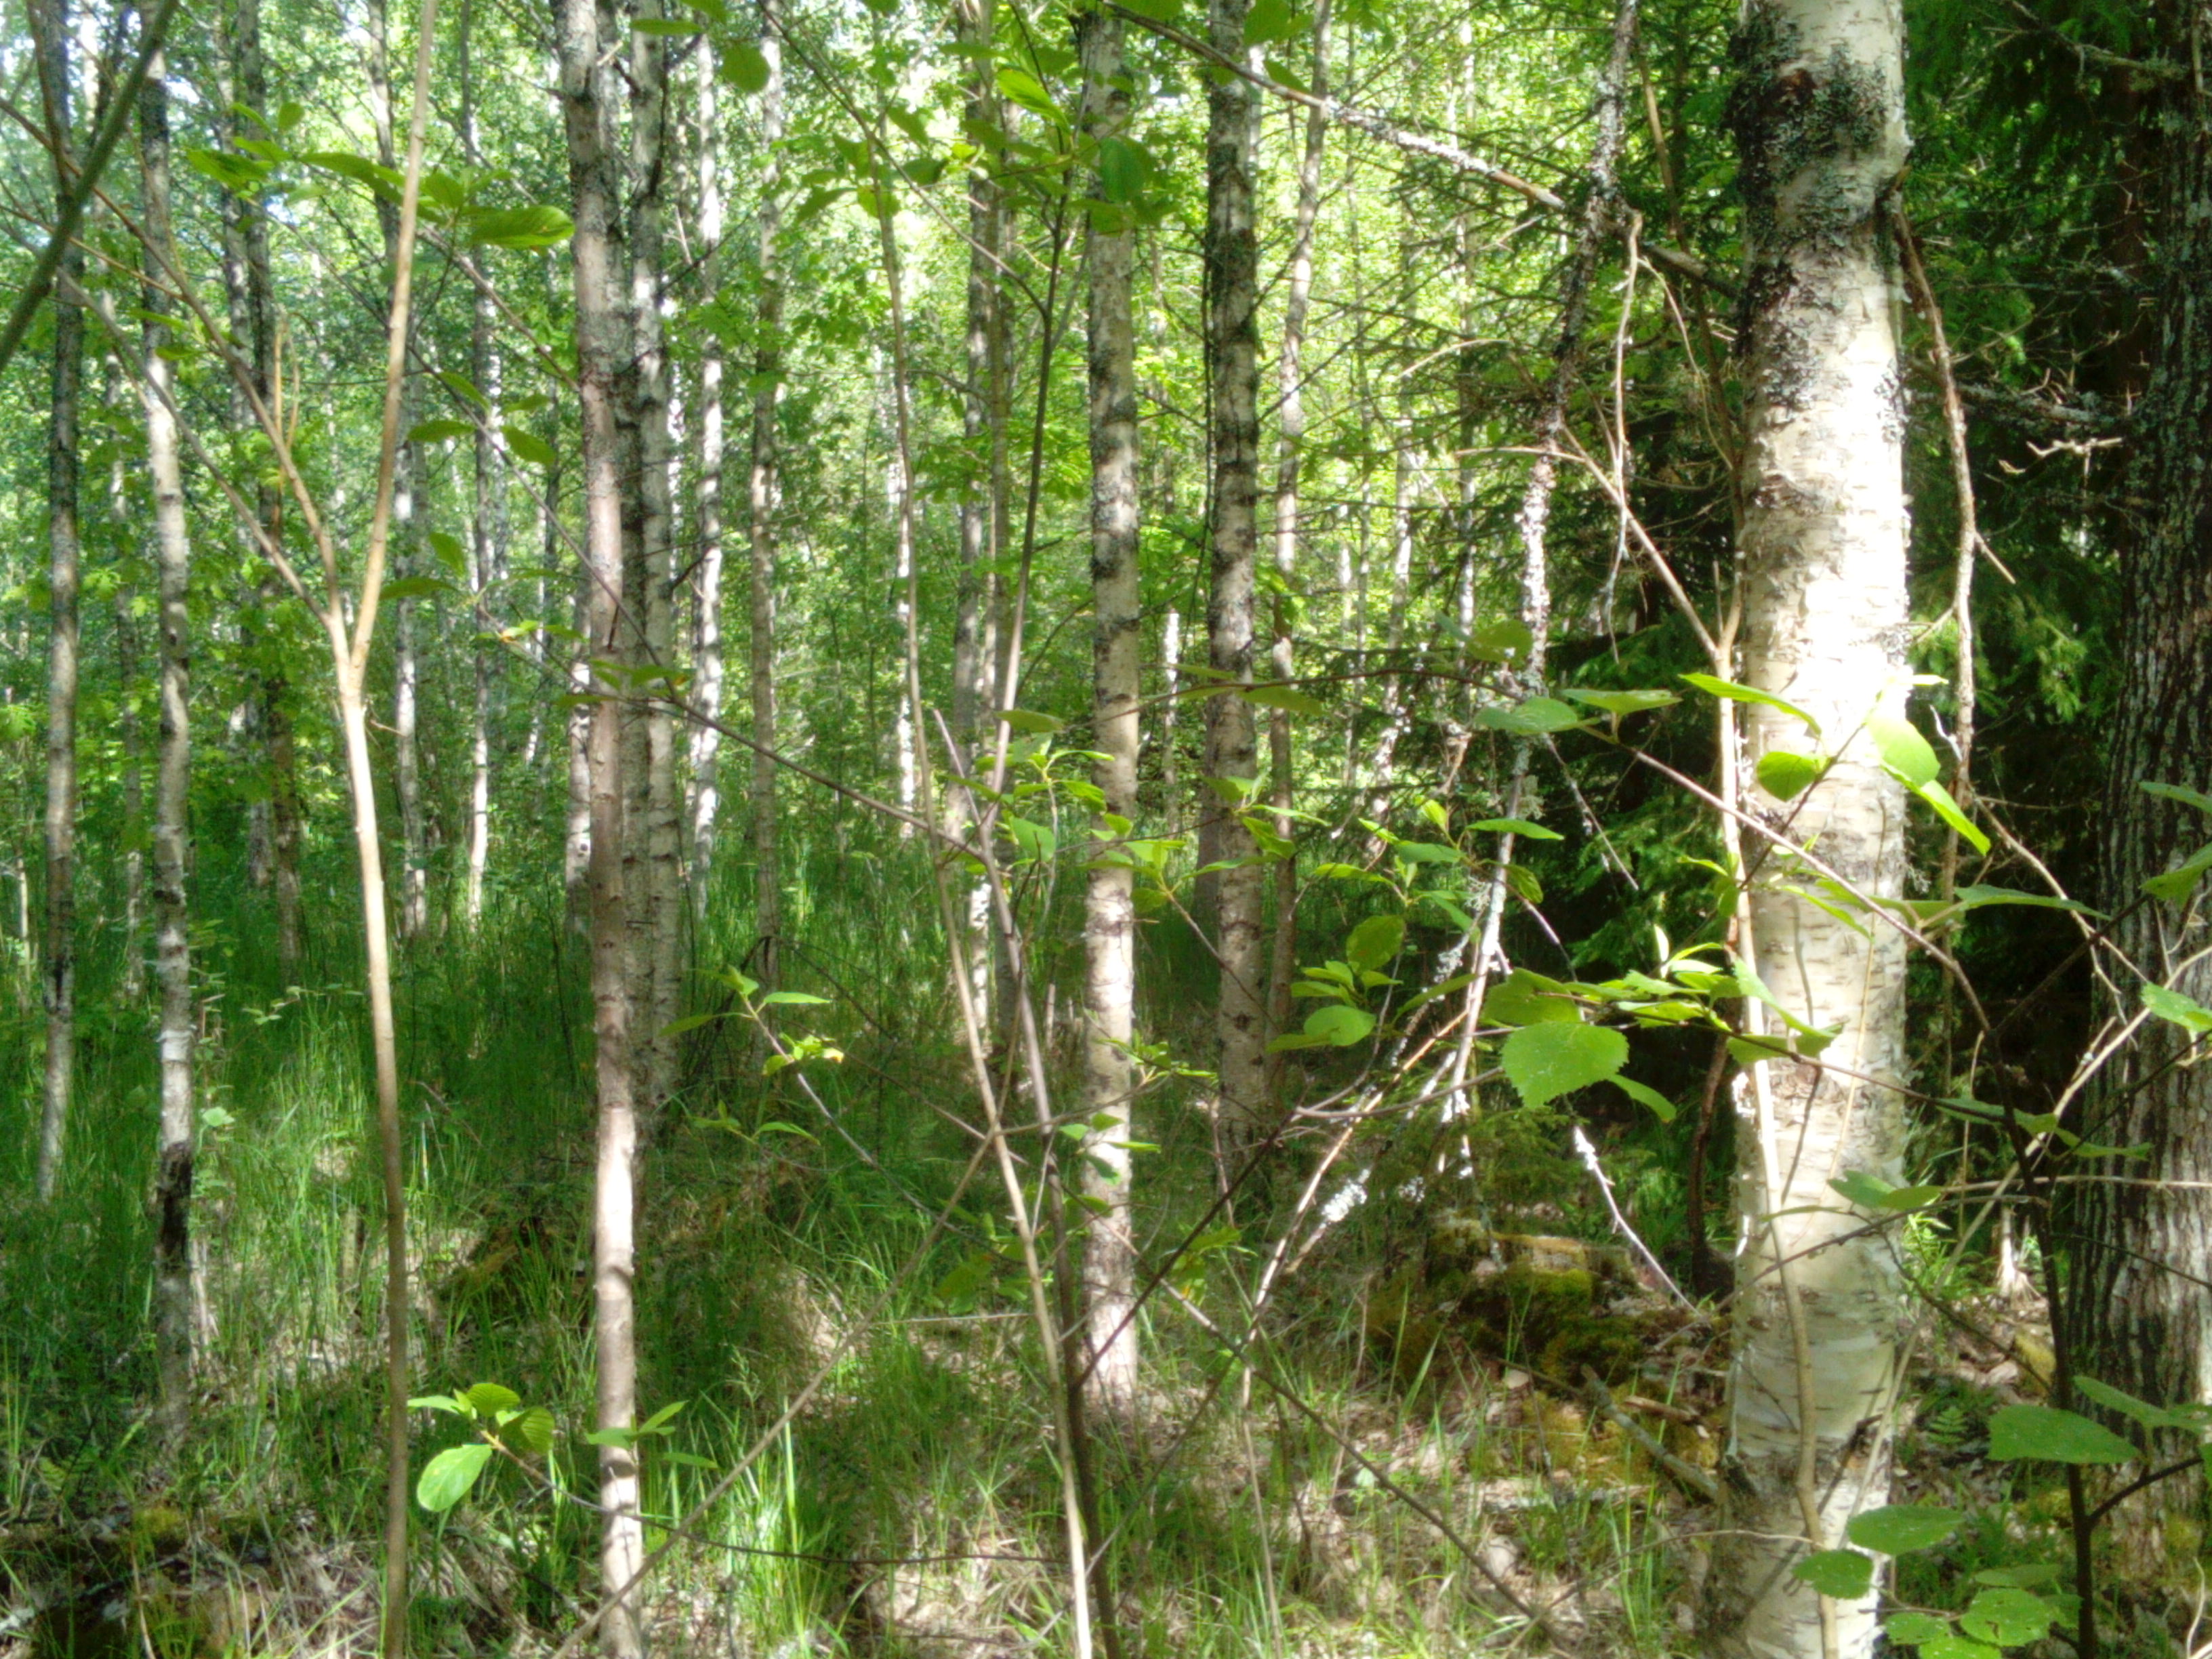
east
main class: Woodland
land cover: Broadleaved woodland
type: acidophilous oak and oak-birch forest
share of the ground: > 75 %
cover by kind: broadleaved forest trees 80 %, coniferous forest trees 15 %, herbaceous plants 5 %
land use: Forestry
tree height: > 5 m
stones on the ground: < 10 %
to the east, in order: Broadleaved woodland; Ditches and canals; Broadleaved woodland; Spruce dominated mixed woodland
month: June
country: LV
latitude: 56.7086
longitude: 22.2548
